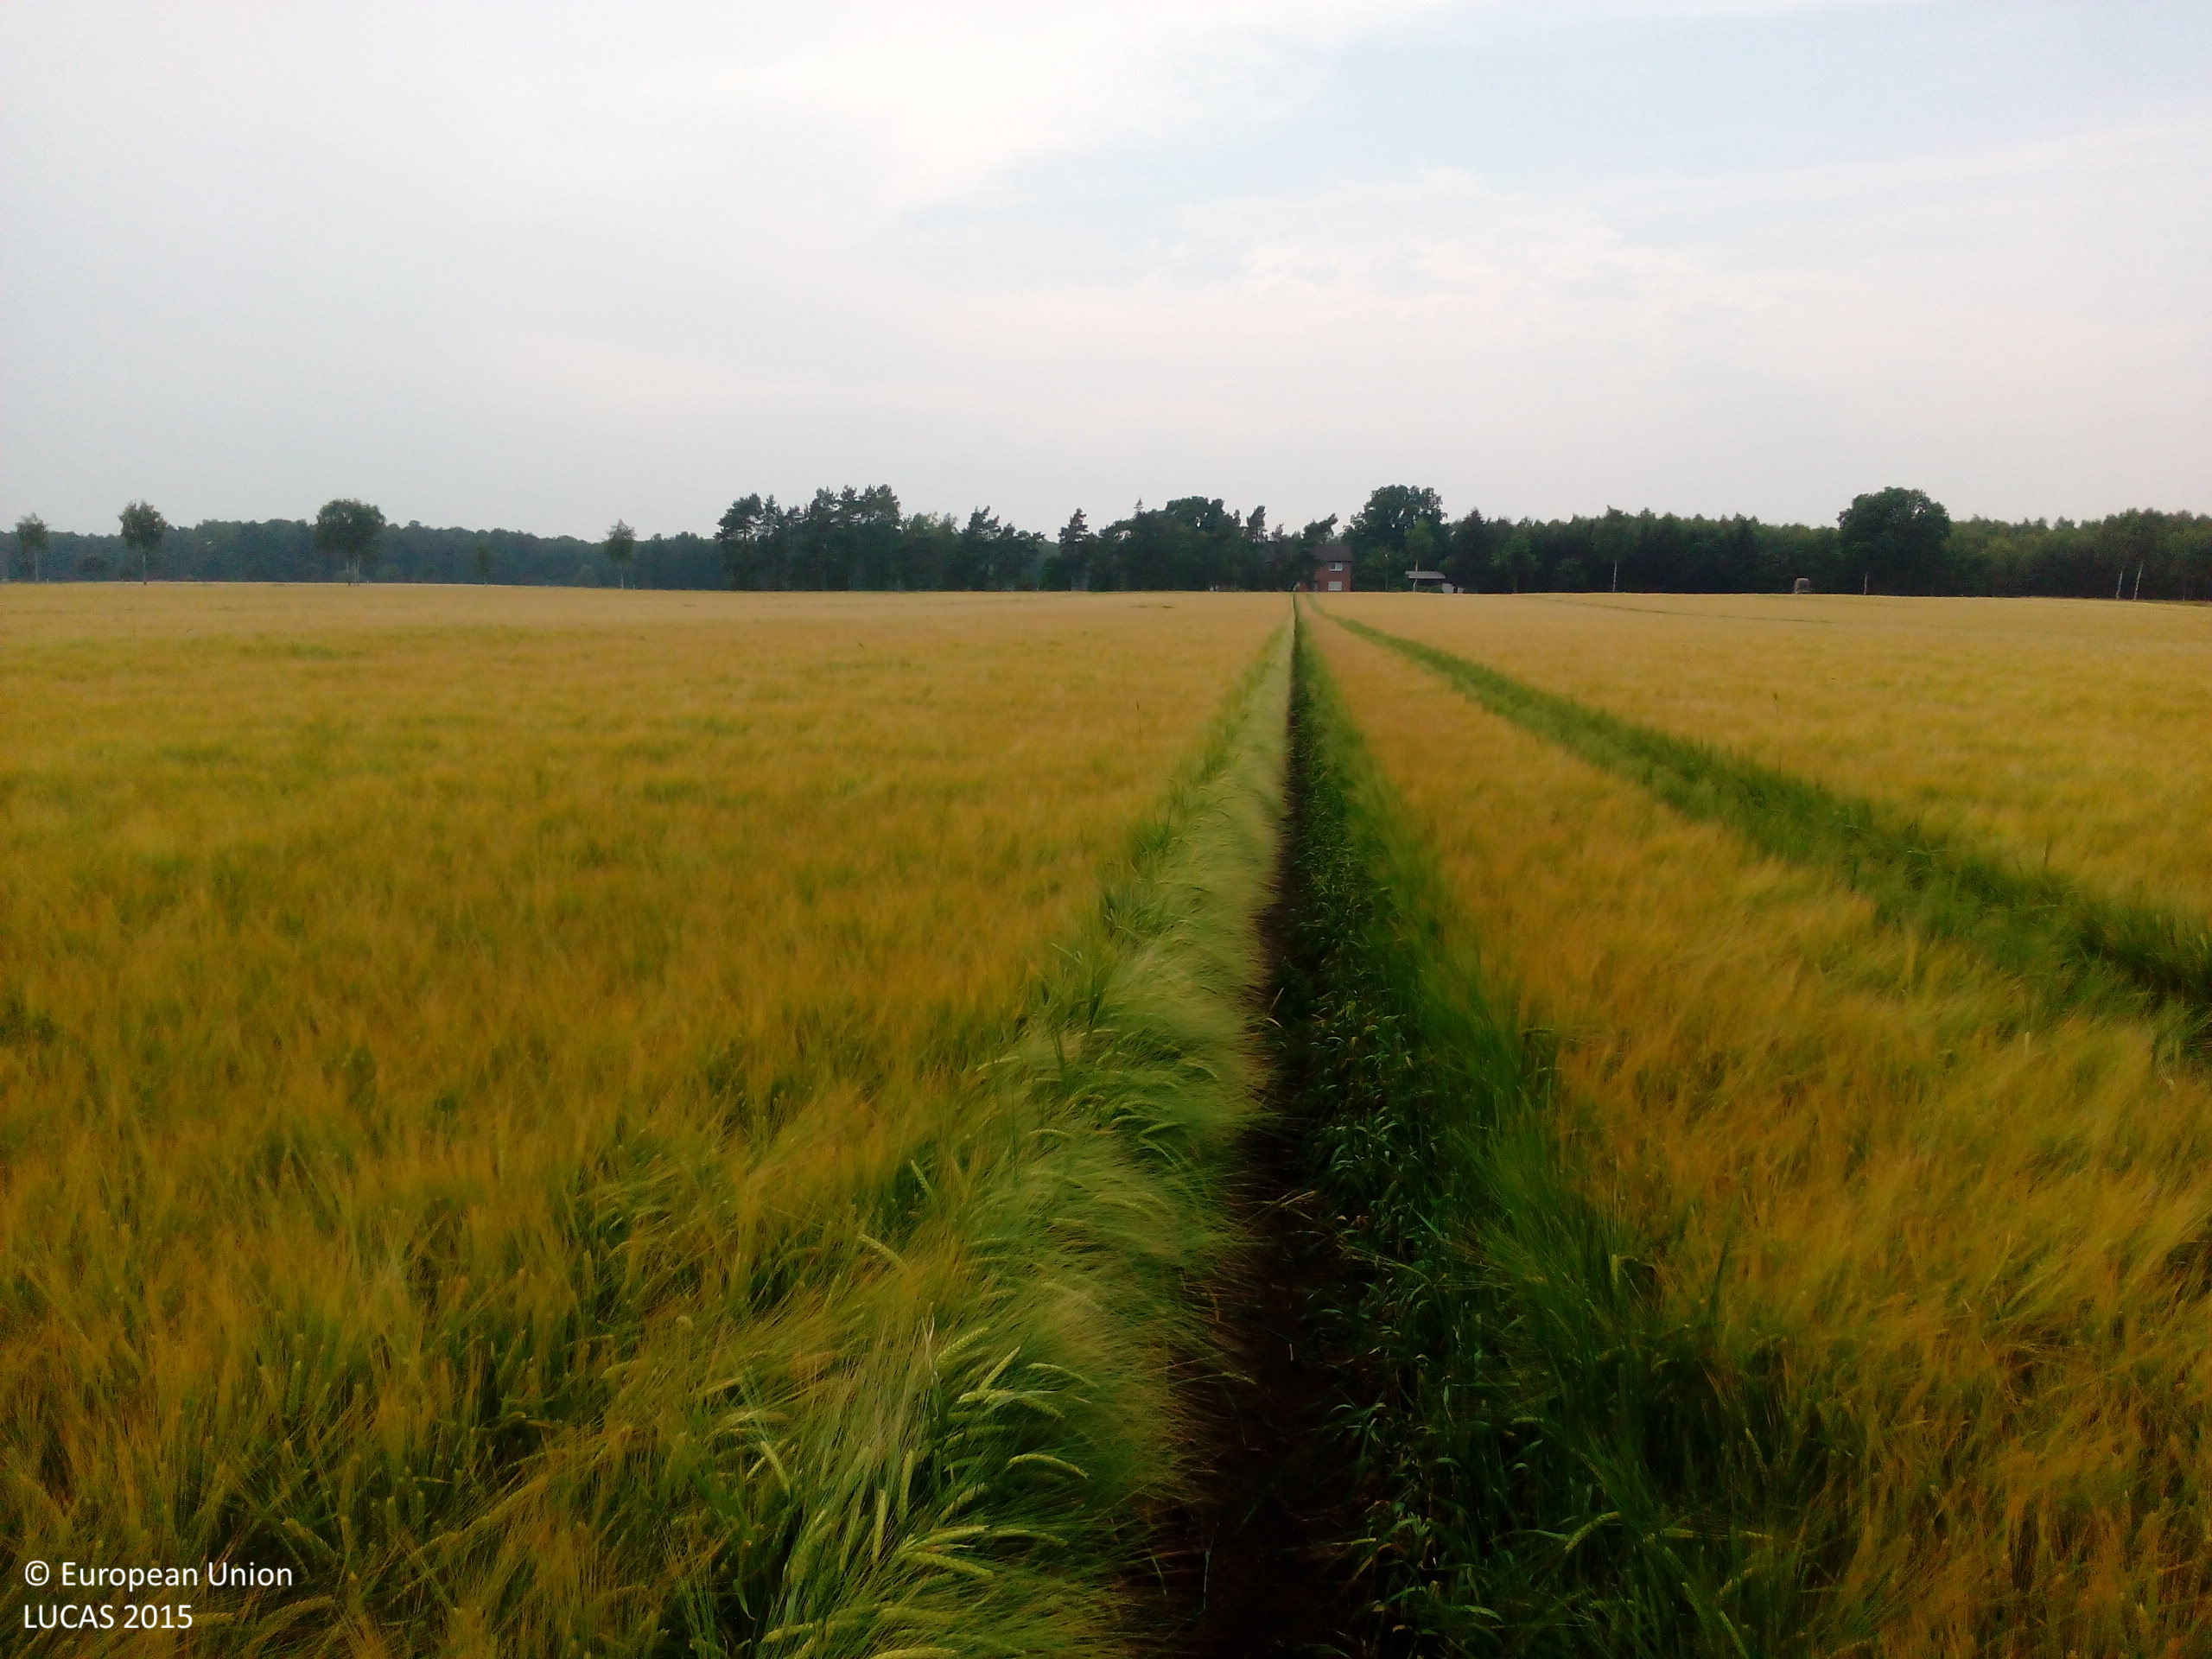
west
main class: Cropland
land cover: Barley
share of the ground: > 75 %
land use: Agriculture (excluding fallow land and kitchen gardens)
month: July
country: DE
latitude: 52.6271
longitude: 10.6941
